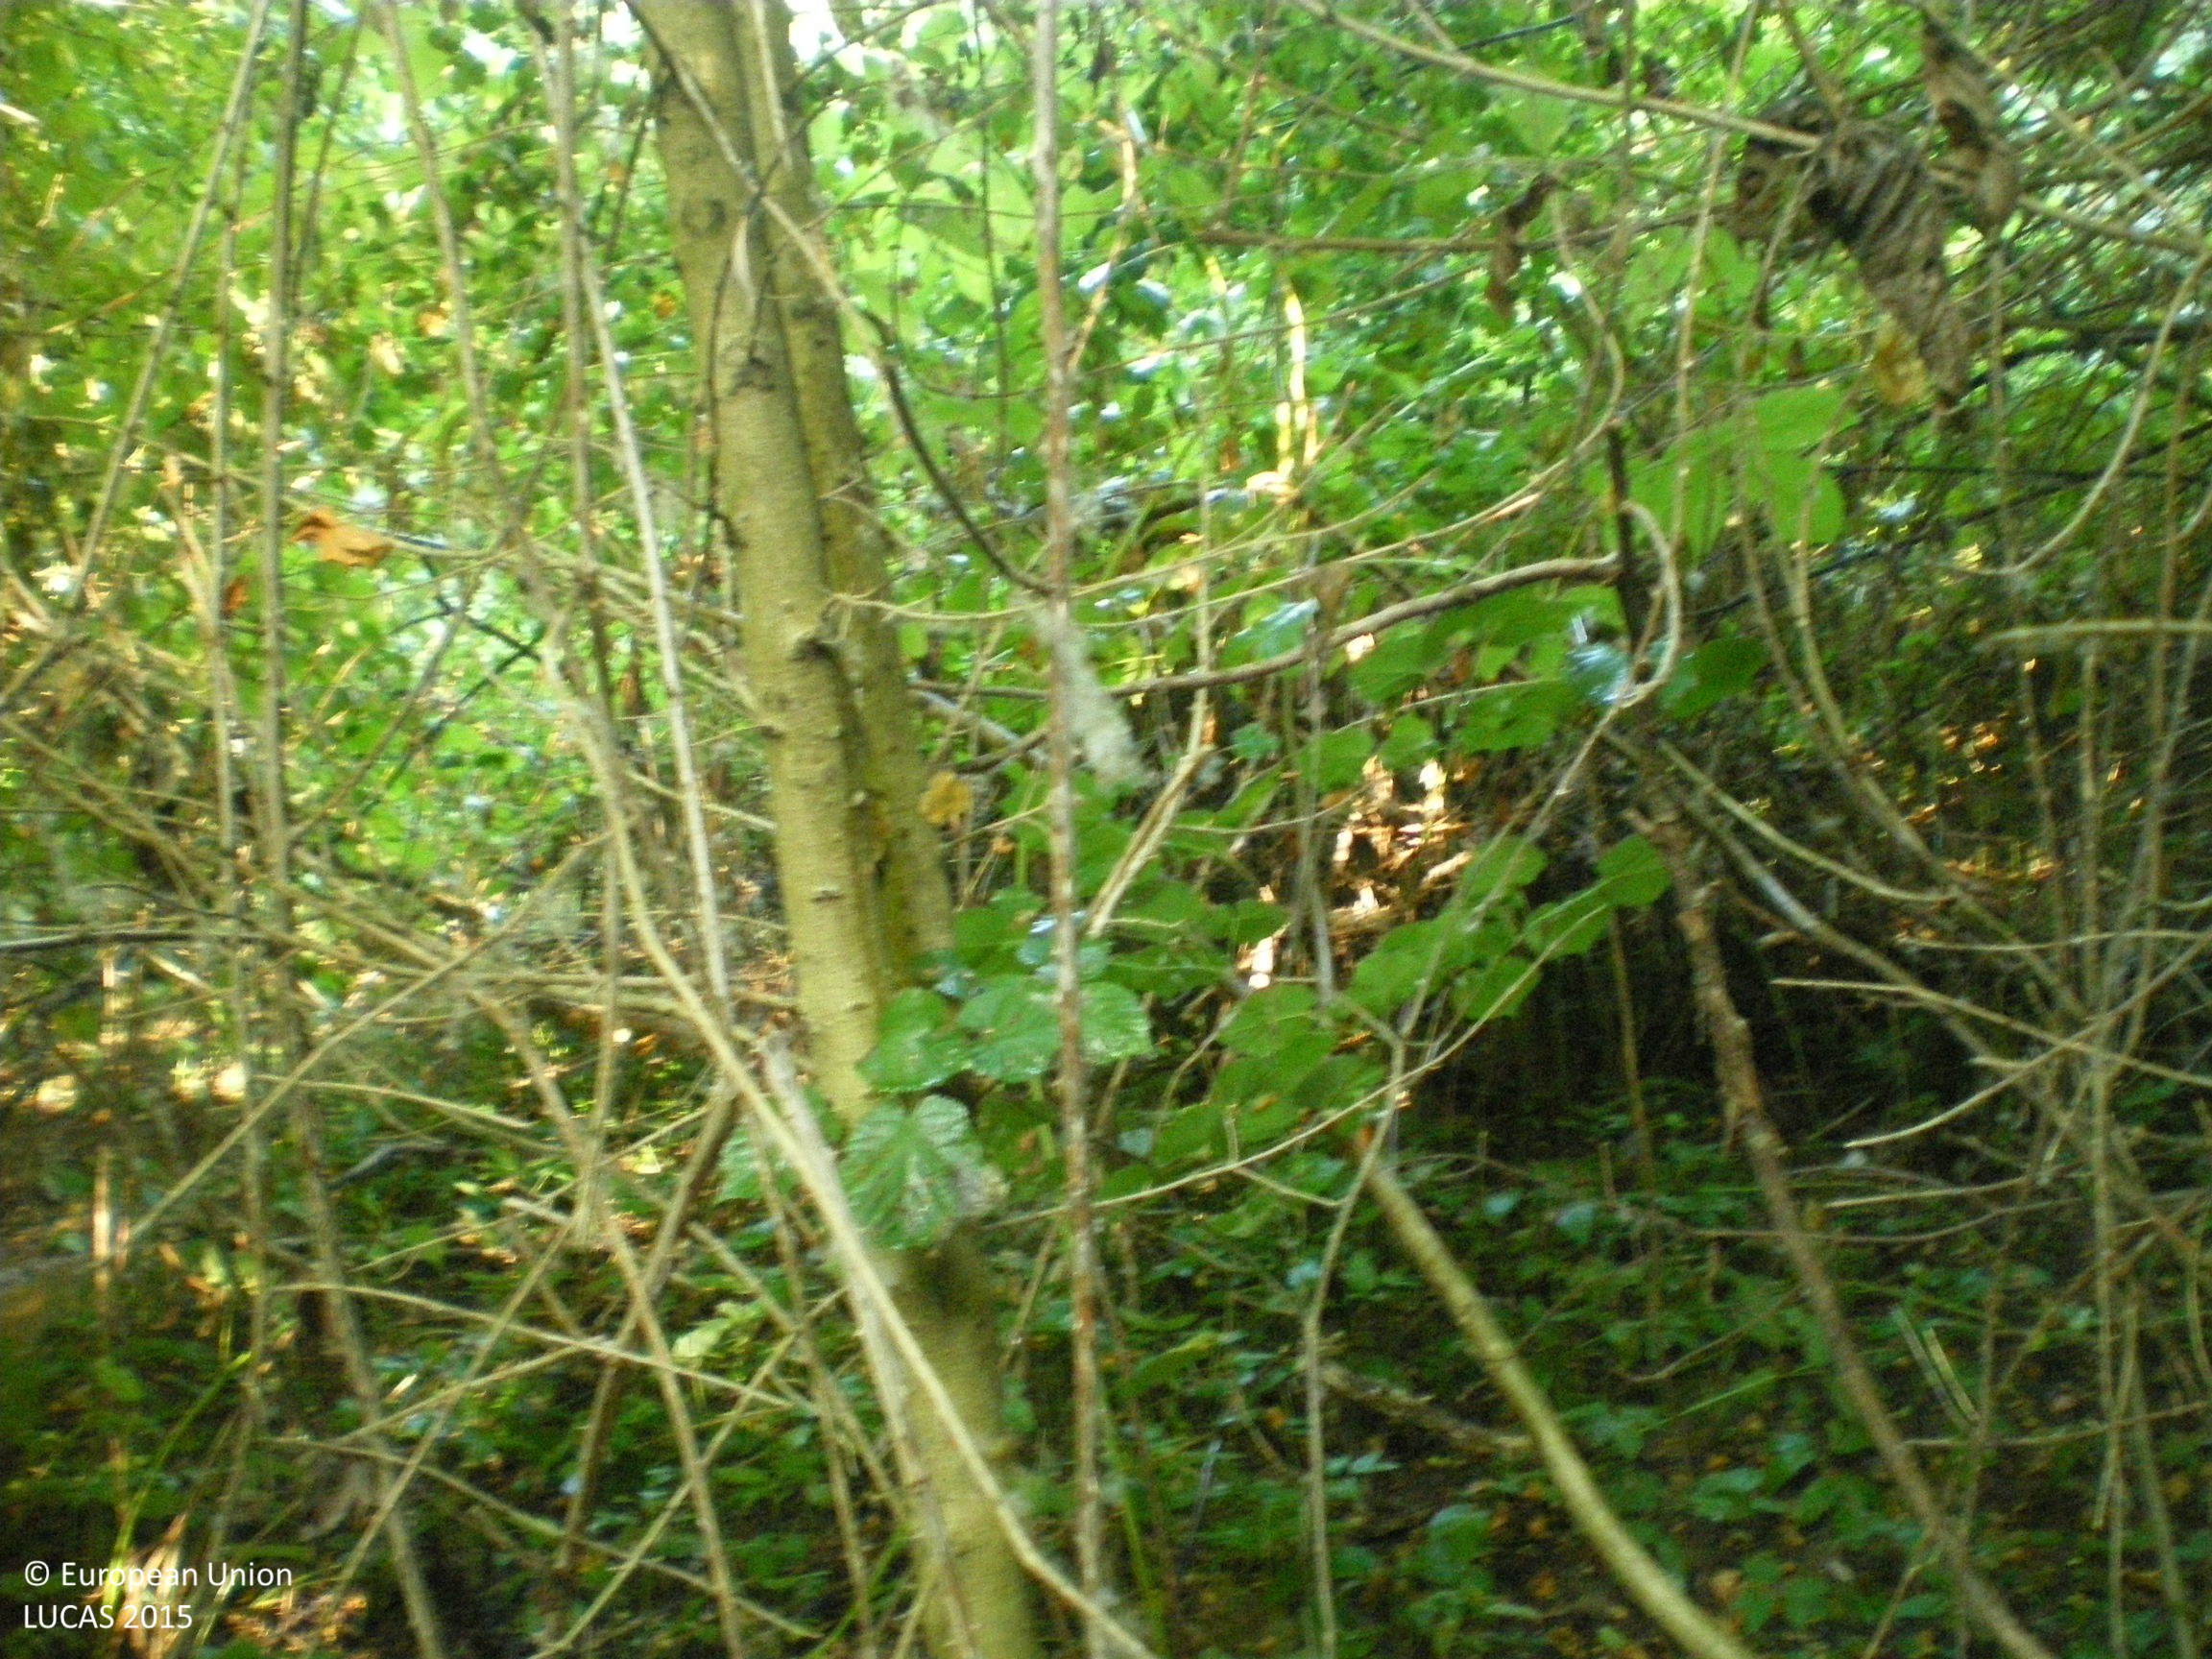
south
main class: Woodland
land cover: Broadleaved woodland
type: mesophytic deciduous forest
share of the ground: > 75 %
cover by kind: broadleaved forest trees 100 %
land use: Forestry
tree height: > 5 m
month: August
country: BG
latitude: 42.3910
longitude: 25.4836
